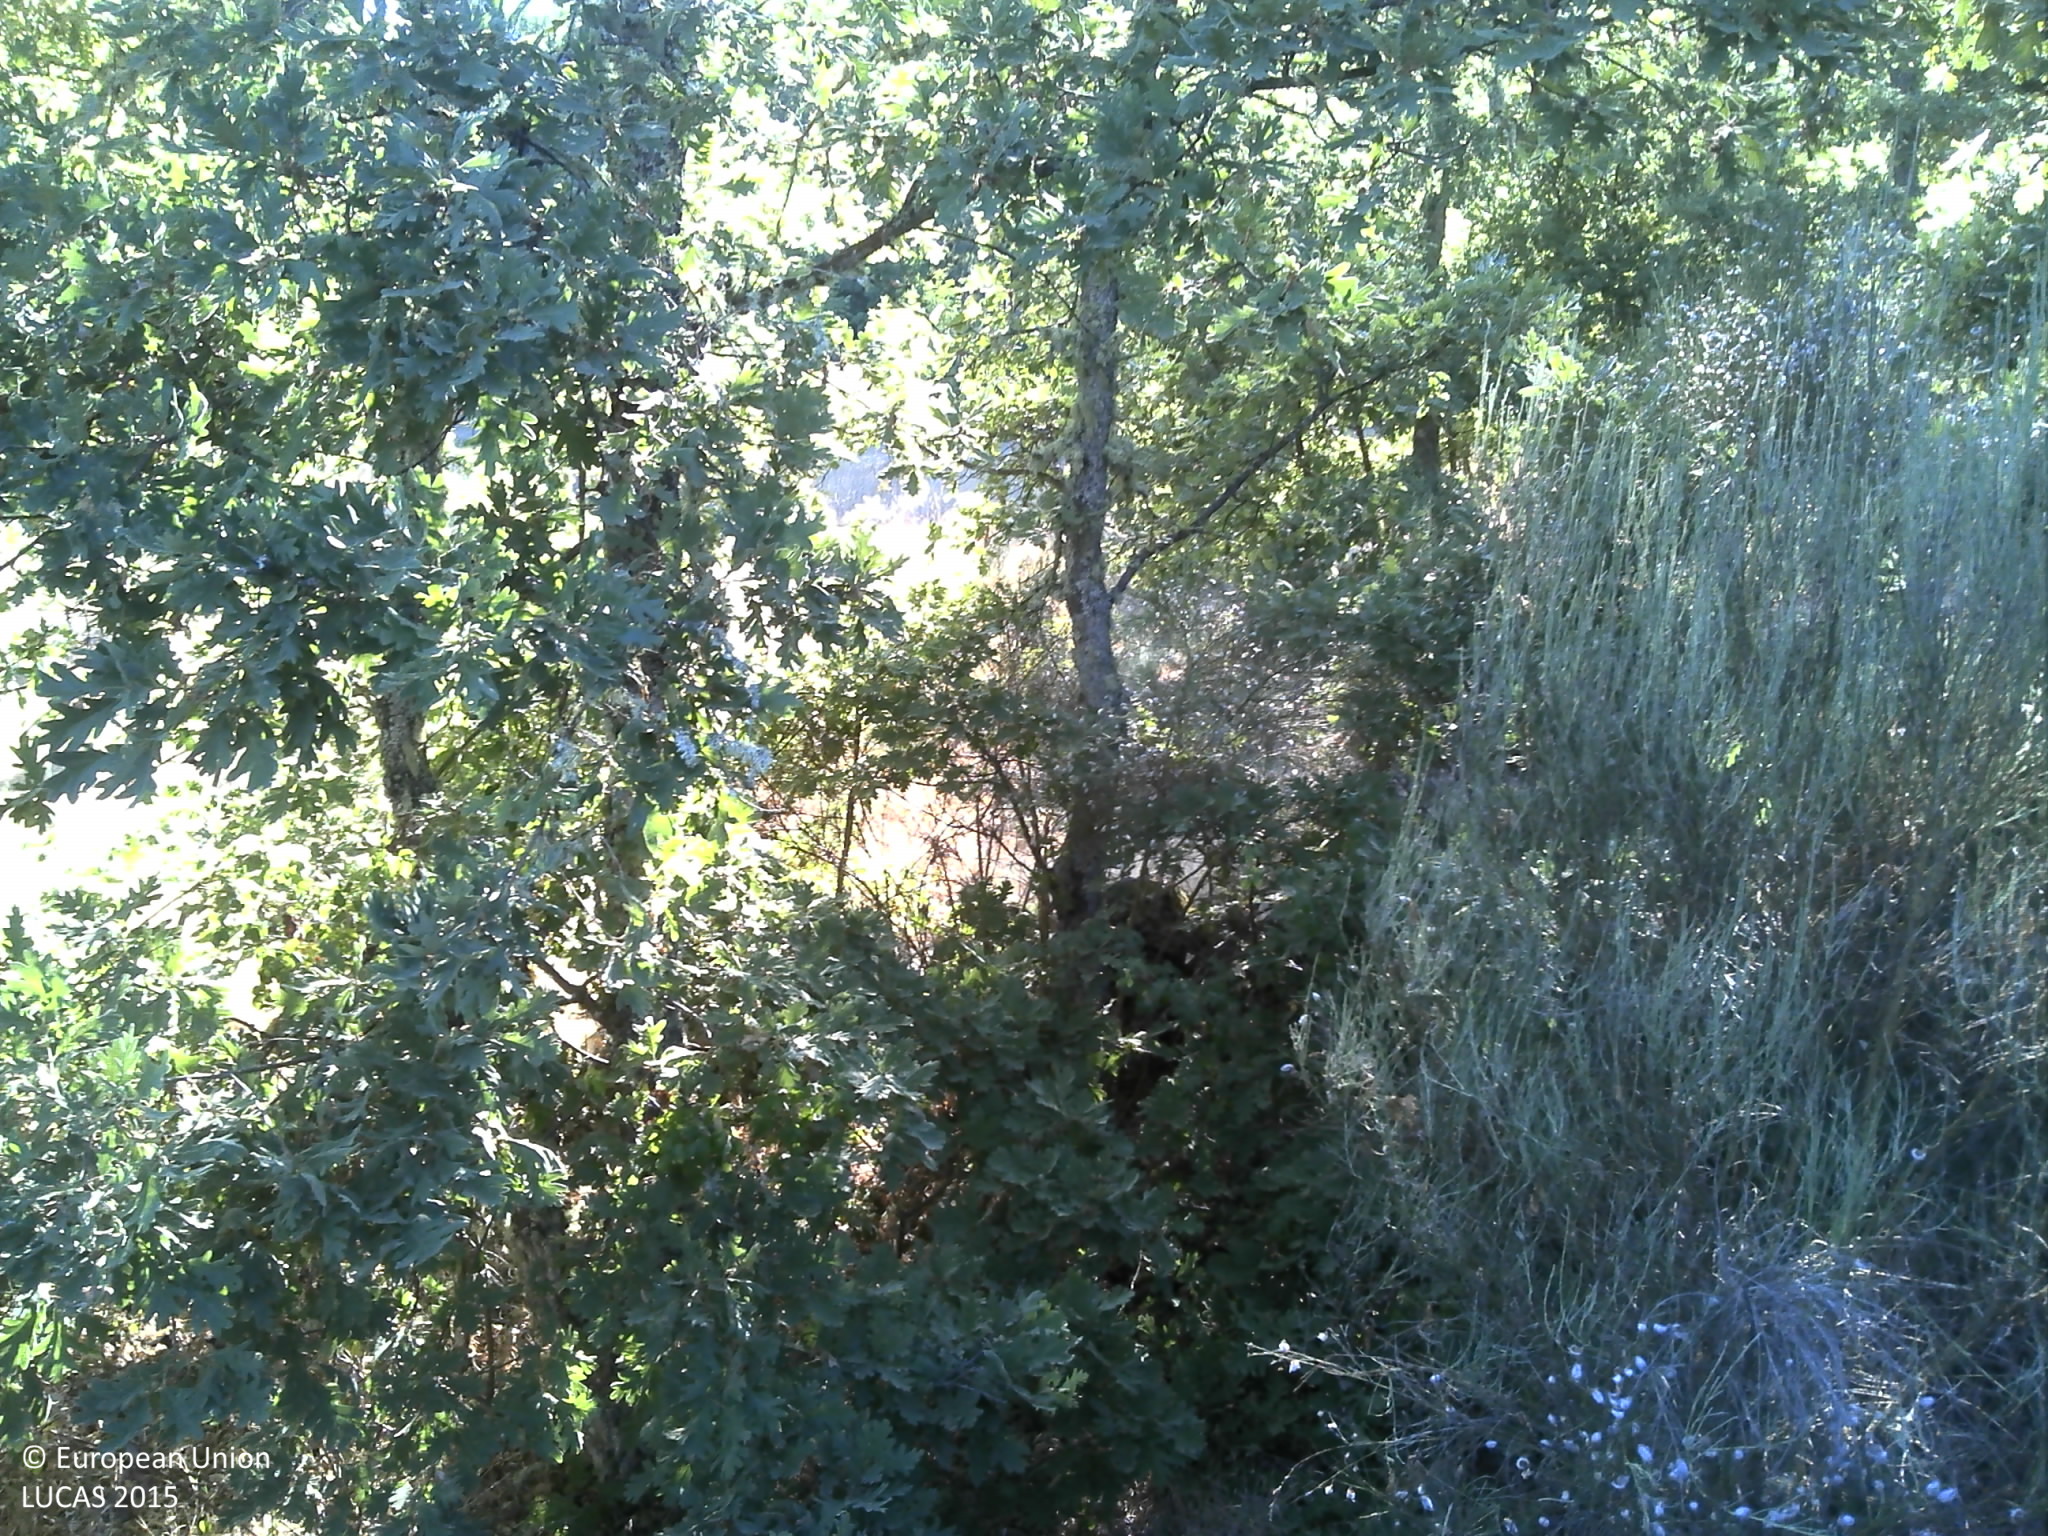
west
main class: Woodland
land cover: Broadleaved woodland
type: thermophilous deciduous forest
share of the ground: 10 - 25 %
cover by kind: consolidated bare surface 45 %, broadleaved forest trees 20 %, shrubs 20 %, herbaceous plants 10 %, unconsolidated bare surface 5 %
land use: Semi-natural and natural areas not in use
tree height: > 5 m
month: July
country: PT
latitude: 41.3749
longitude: -7.4980
